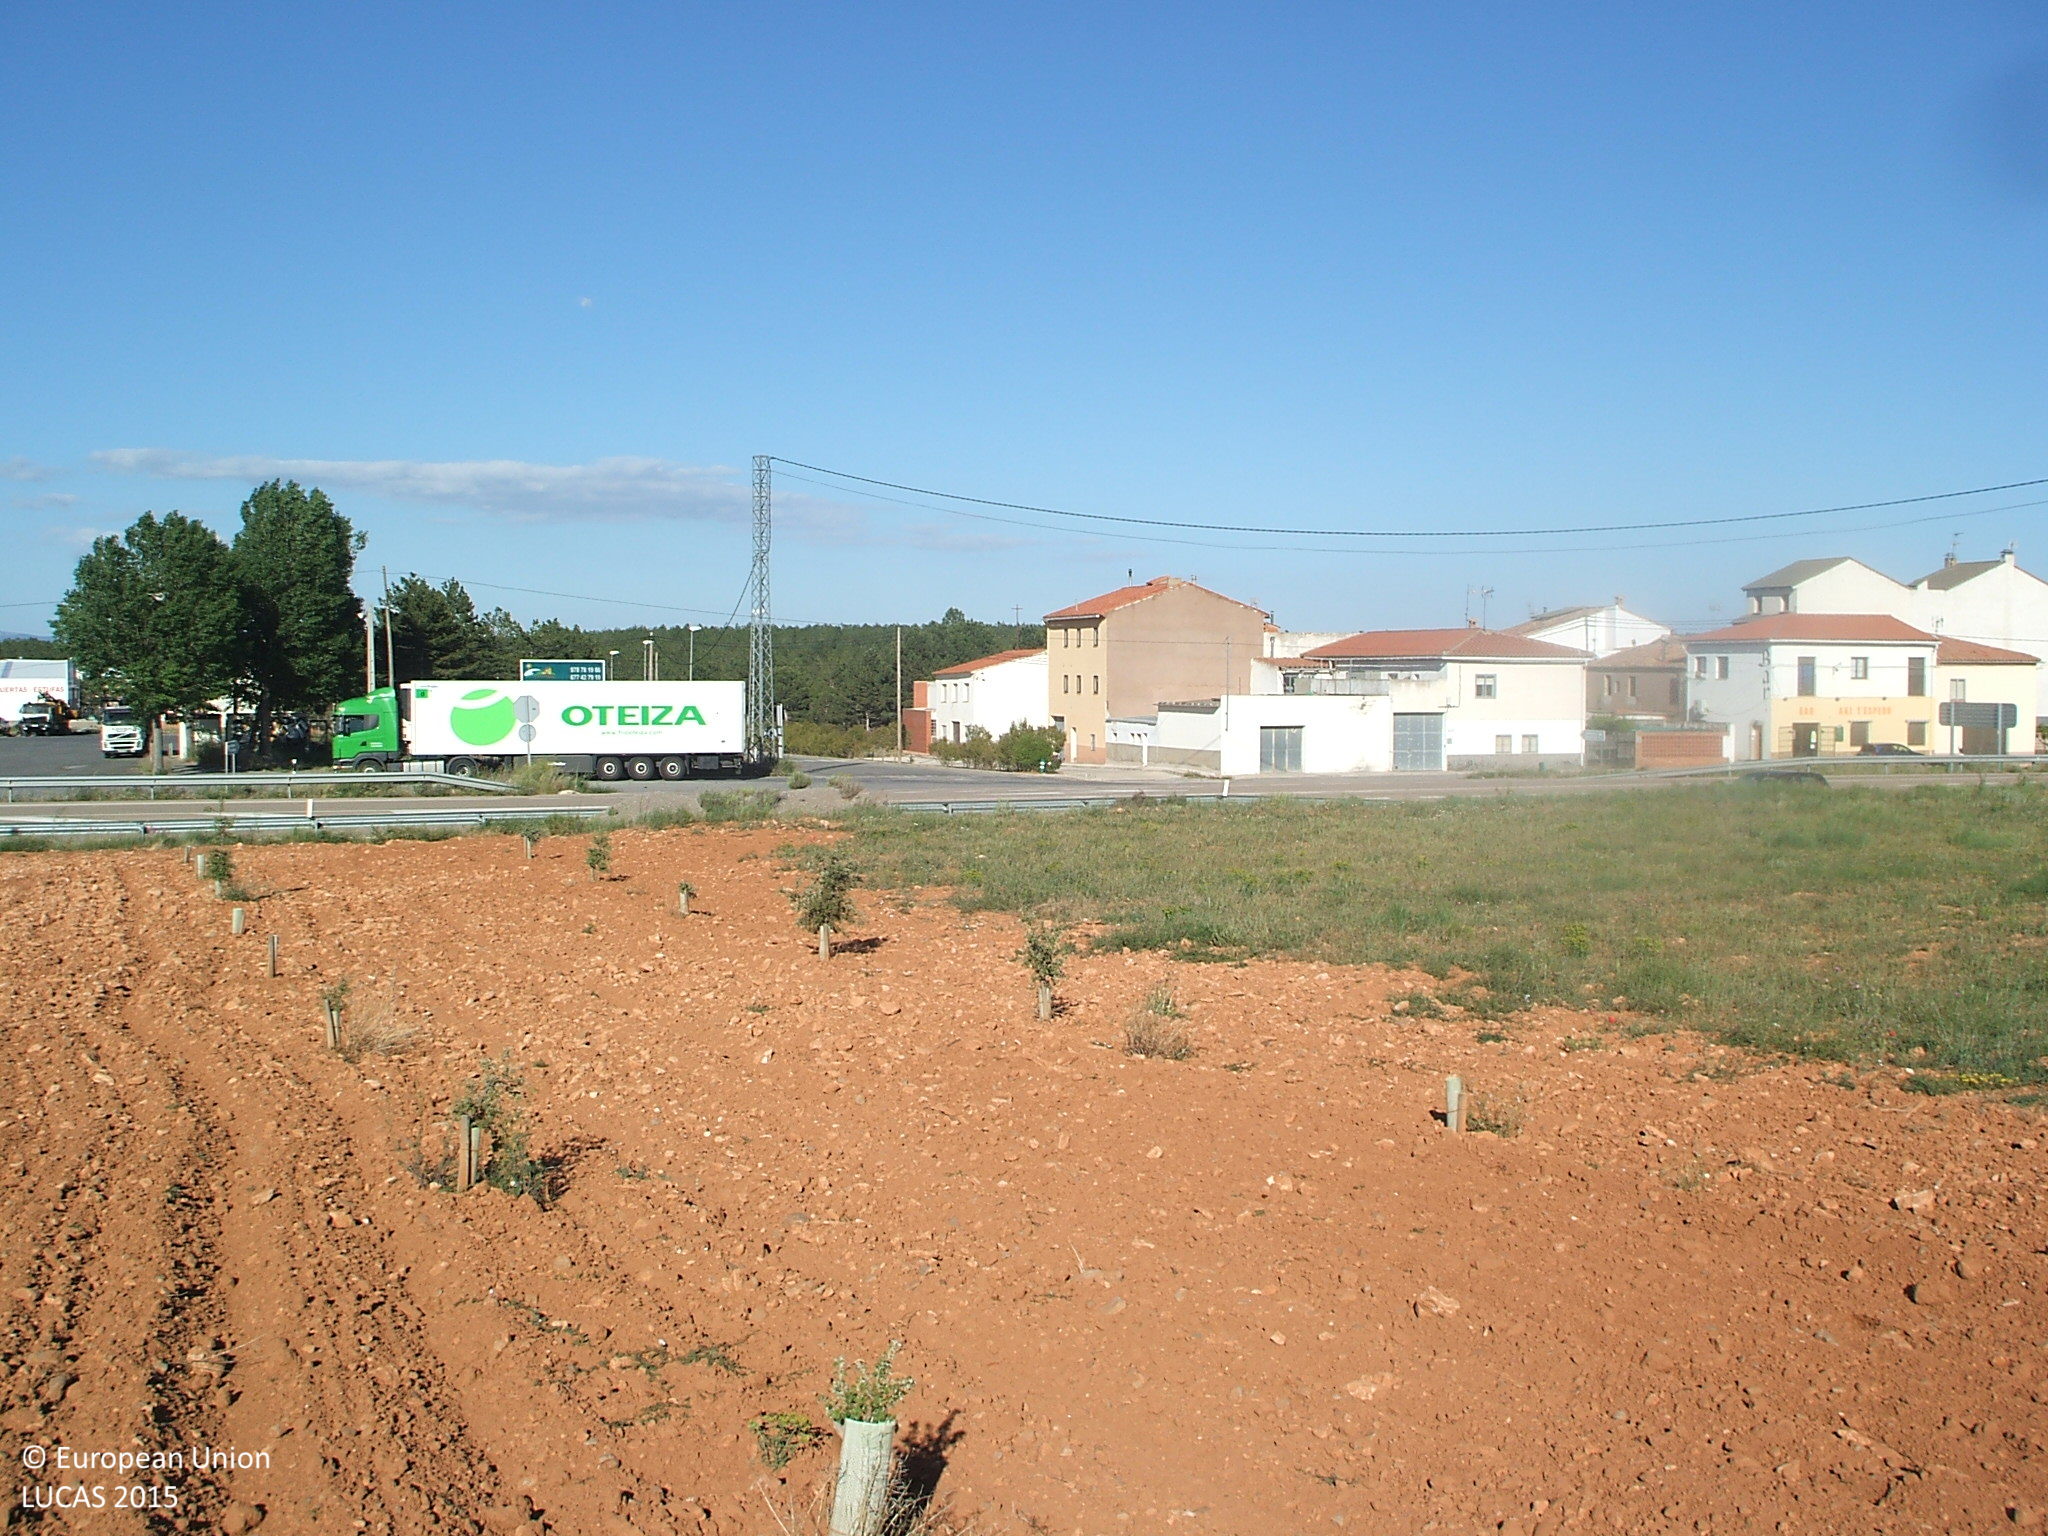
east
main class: Woodland
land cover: Broadleaved woodland
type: broadleaved evergreen forest
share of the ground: 10 - 25 %
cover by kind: unconsolidated bare surface 85 %, broadleaved forest trees 15 %
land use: Forestry
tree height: < 5 m
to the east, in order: Broadleaved woodland; Artificial constructions in urban areas; Pine dominated coniferous woodland; Tracks; Electric lines; Pine dominated coniferous woodland
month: May
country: ES
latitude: 40.1136
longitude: -0.7413
